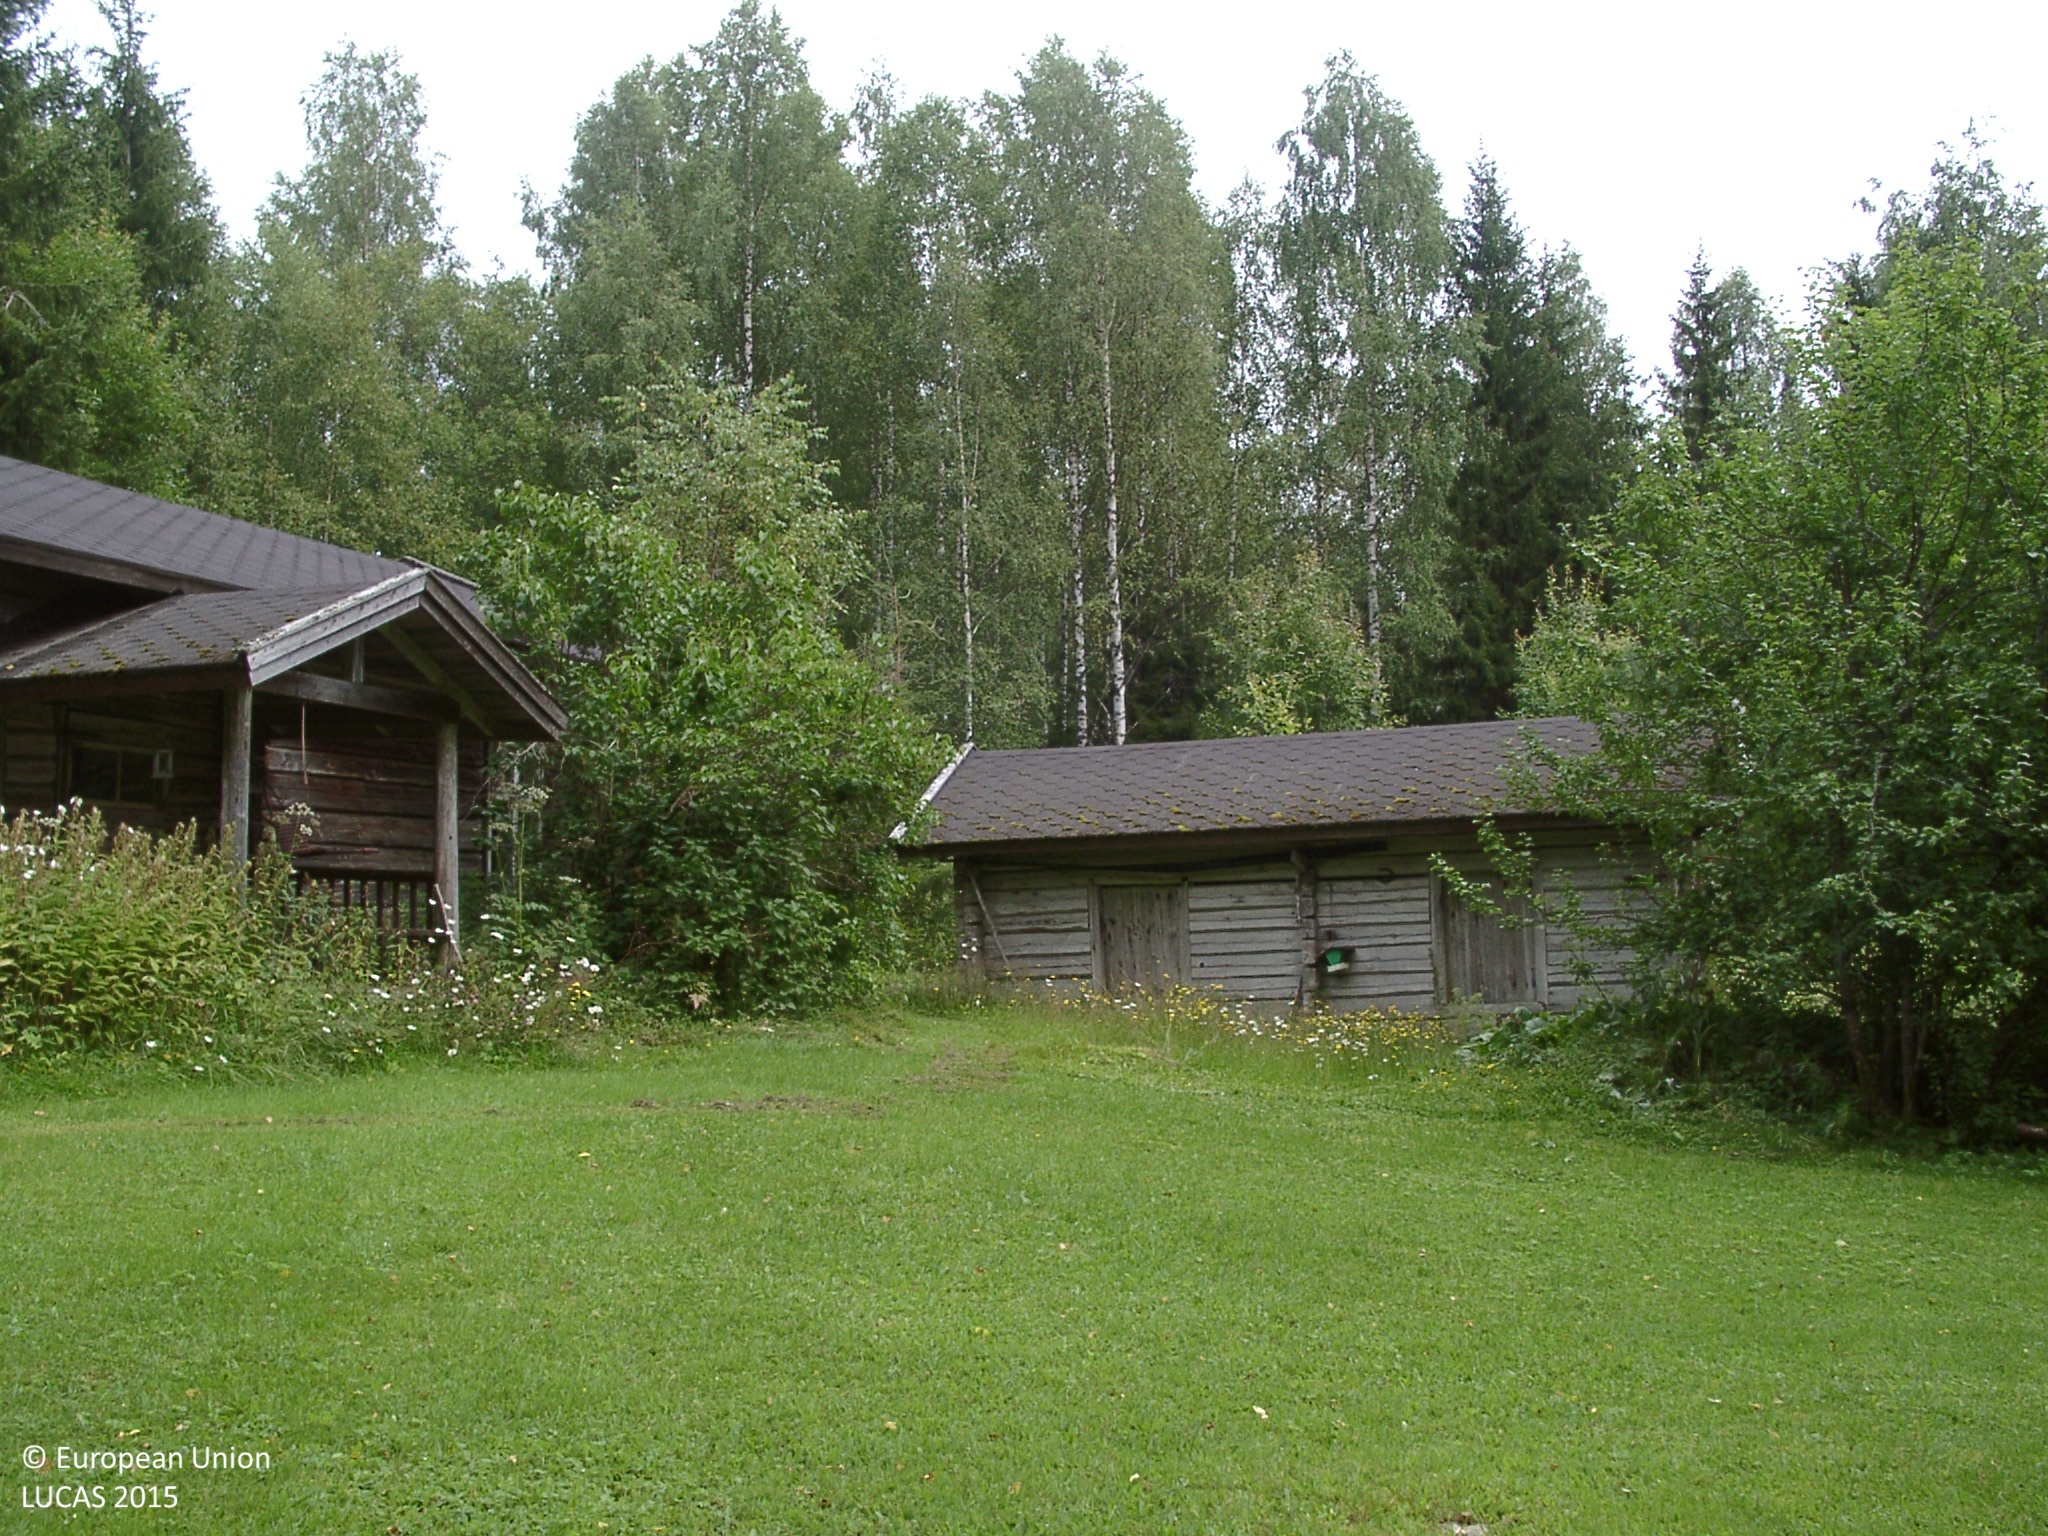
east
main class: Grassland
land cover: Grassland without tree/shrub cover
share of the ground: > 75 %
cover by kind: herbaceous plants 75 %, lichens and mosses 25 %
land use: Residential
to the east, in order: Grassland without tree/shrub cover; Artificial constructions in urban areas; Grassland with sparse tree/shrub cover; Spruce dominated mixed woodland; Broadleaved woodland; Spruce dominated mixed woodland
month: August
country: FI
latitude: 62.4286
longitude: 25.5089
